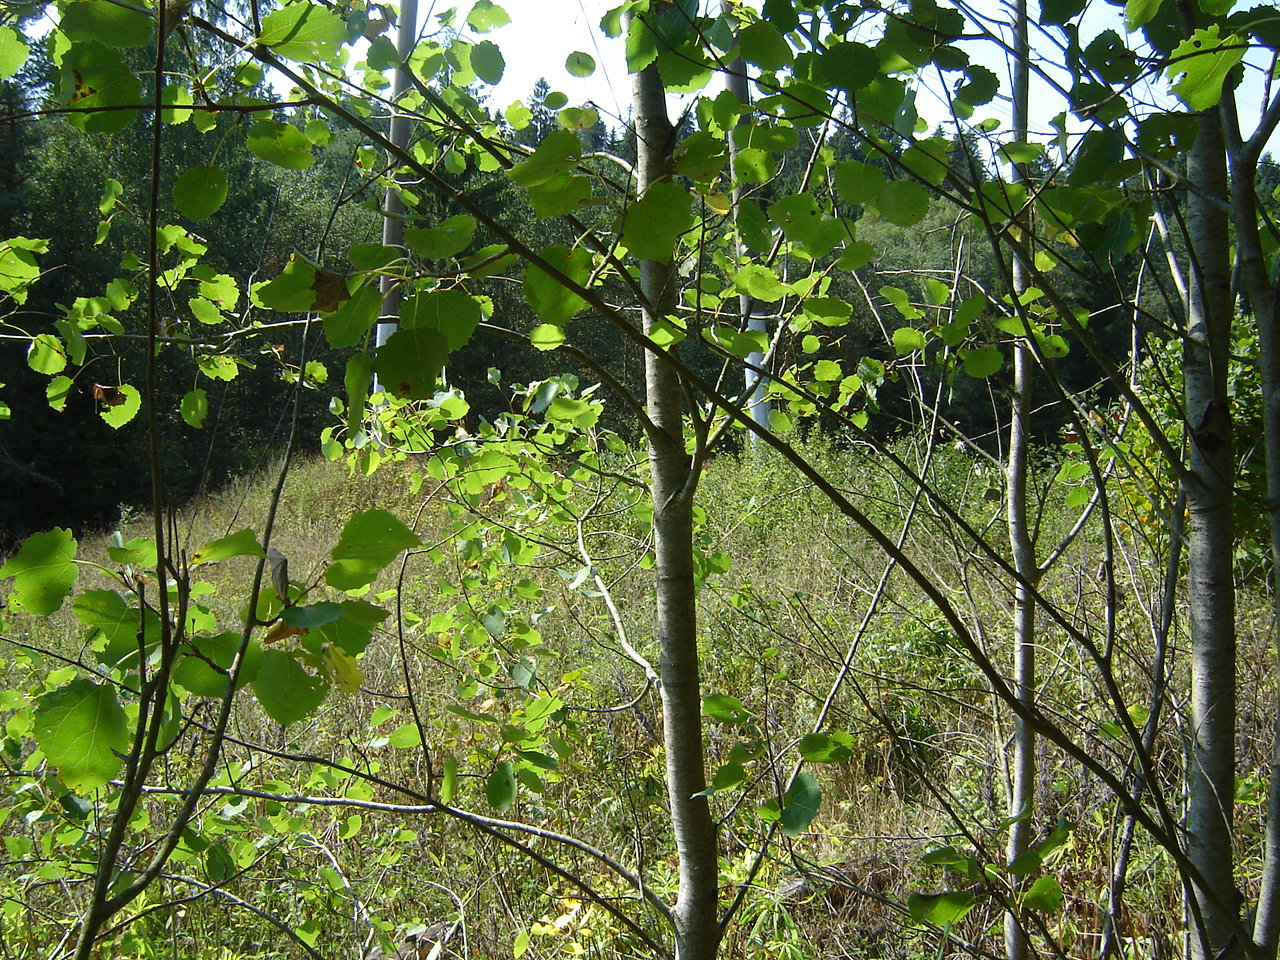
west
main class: Woodland
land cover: Broadleaved woodland
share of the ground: > 75 %
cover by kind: broadleaved forest trees 85 %, herbaceous plants 15 %
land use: Forestry
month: August
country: LT
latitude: 54.6820
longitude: 24.7979
